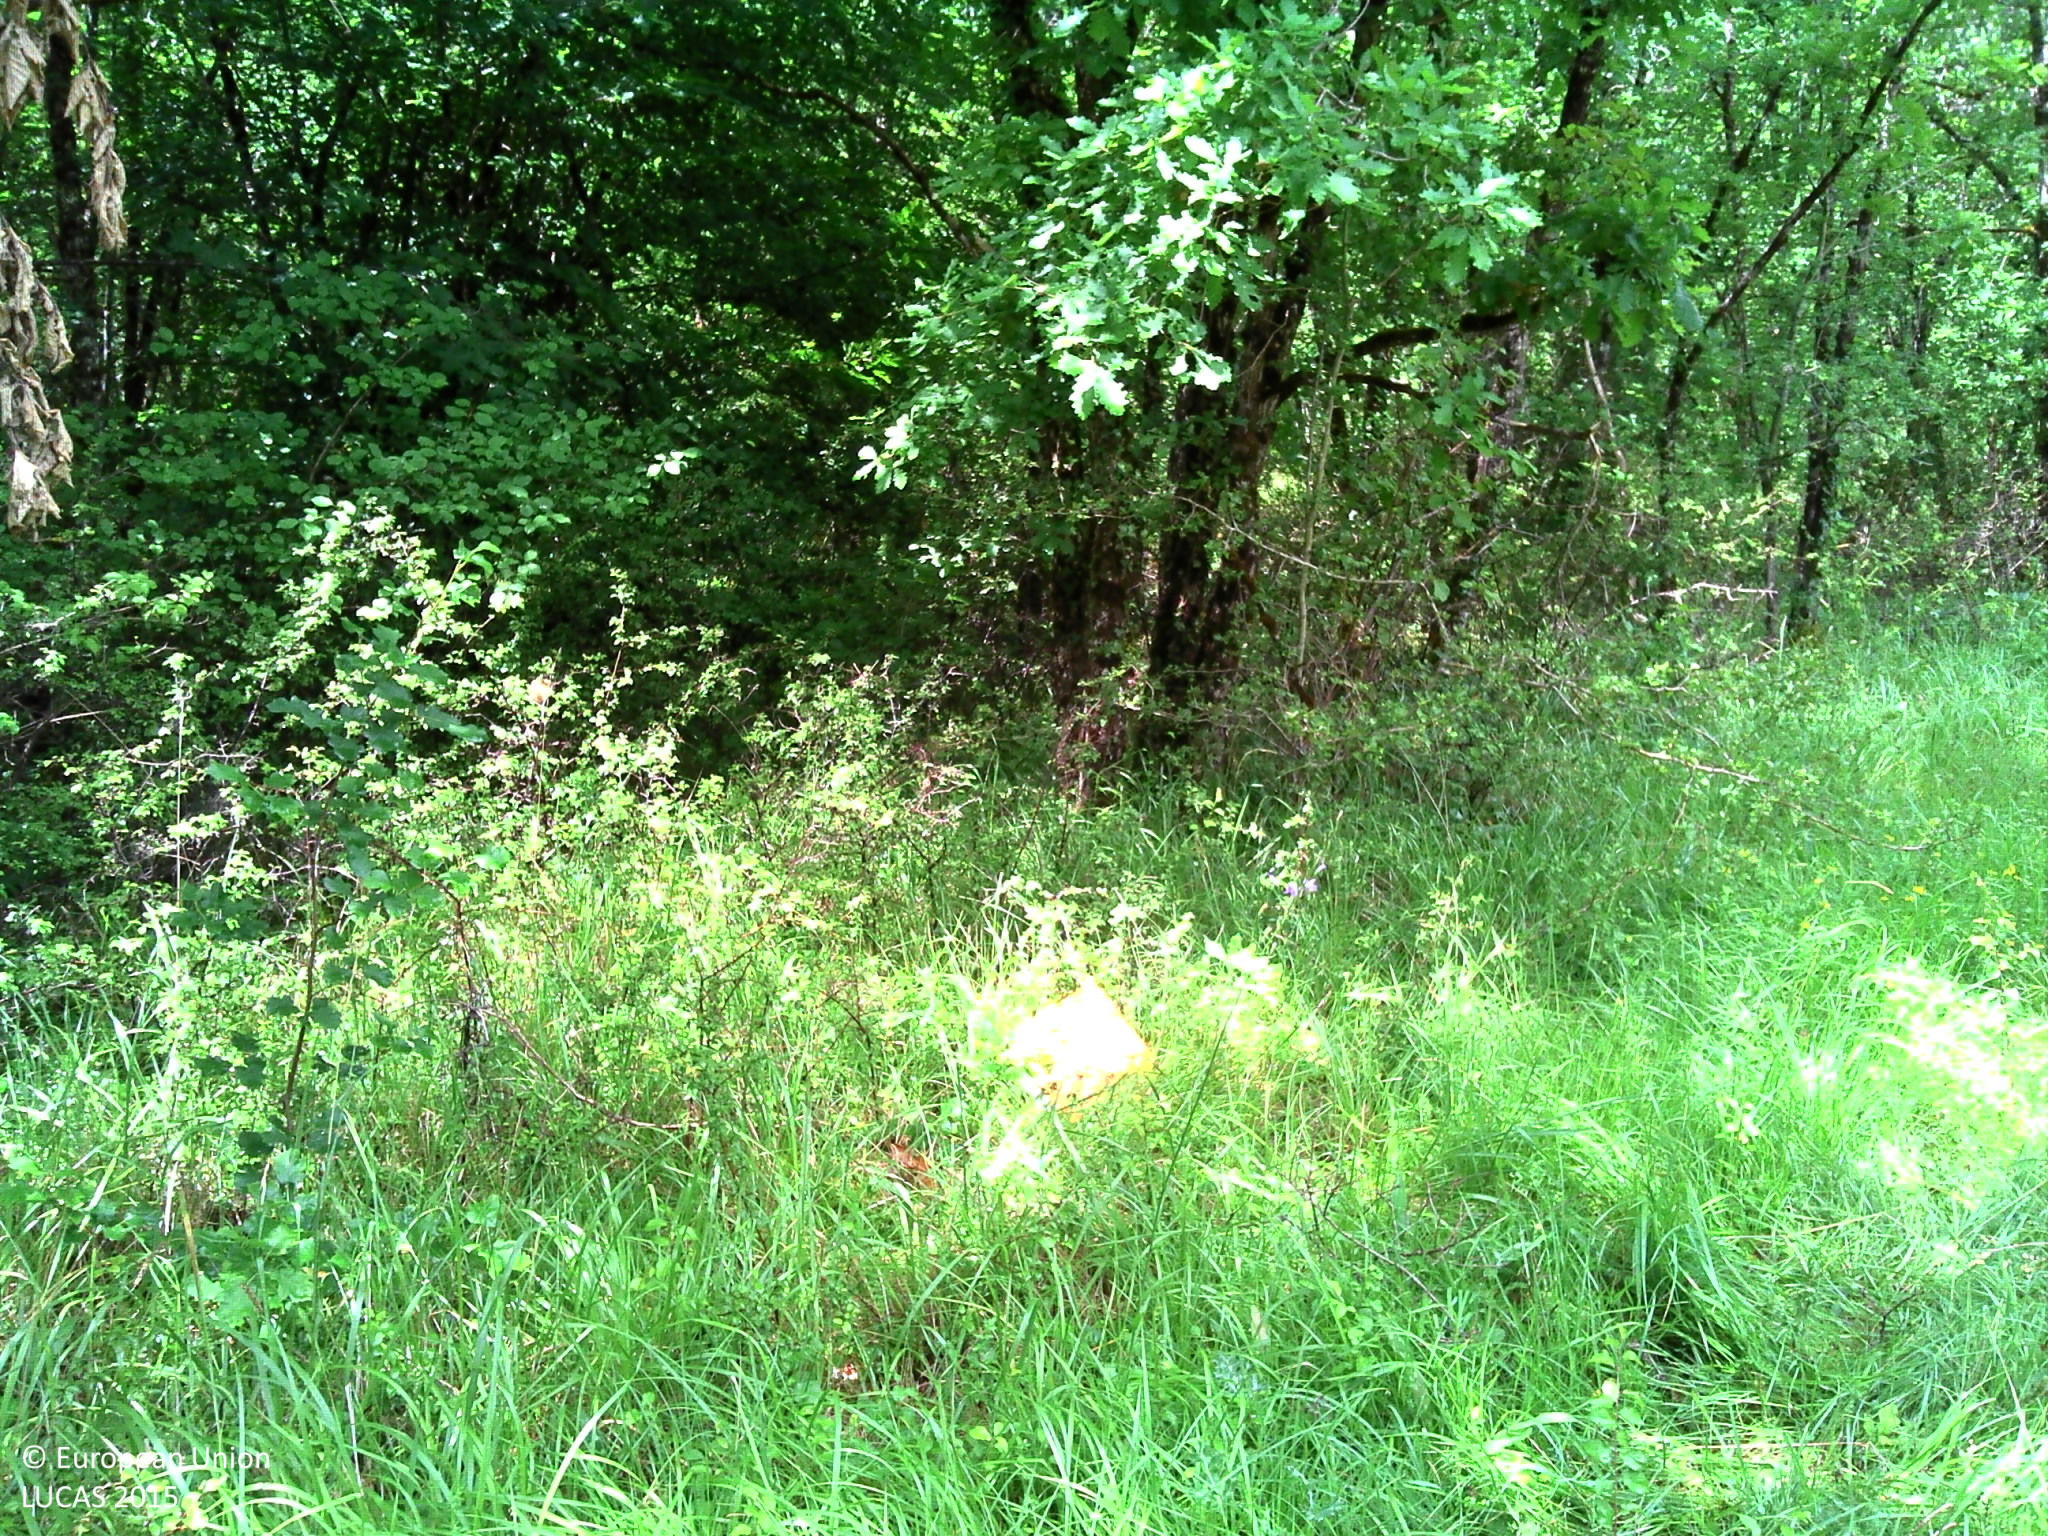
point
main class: Woodland
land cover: Broadleaved woodland
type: acidophilous oak and oak-birch forest
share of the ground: > 75 %
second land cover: Grassland without tree/shrub cover
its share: > 75 %
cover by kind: broadleaved forest trees 85 %, shrubs 10 %, herbaceous plants 5 %
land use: Forestry
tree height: > 5 m
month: June
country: FR
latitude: 44.3404
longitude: 1.8856
